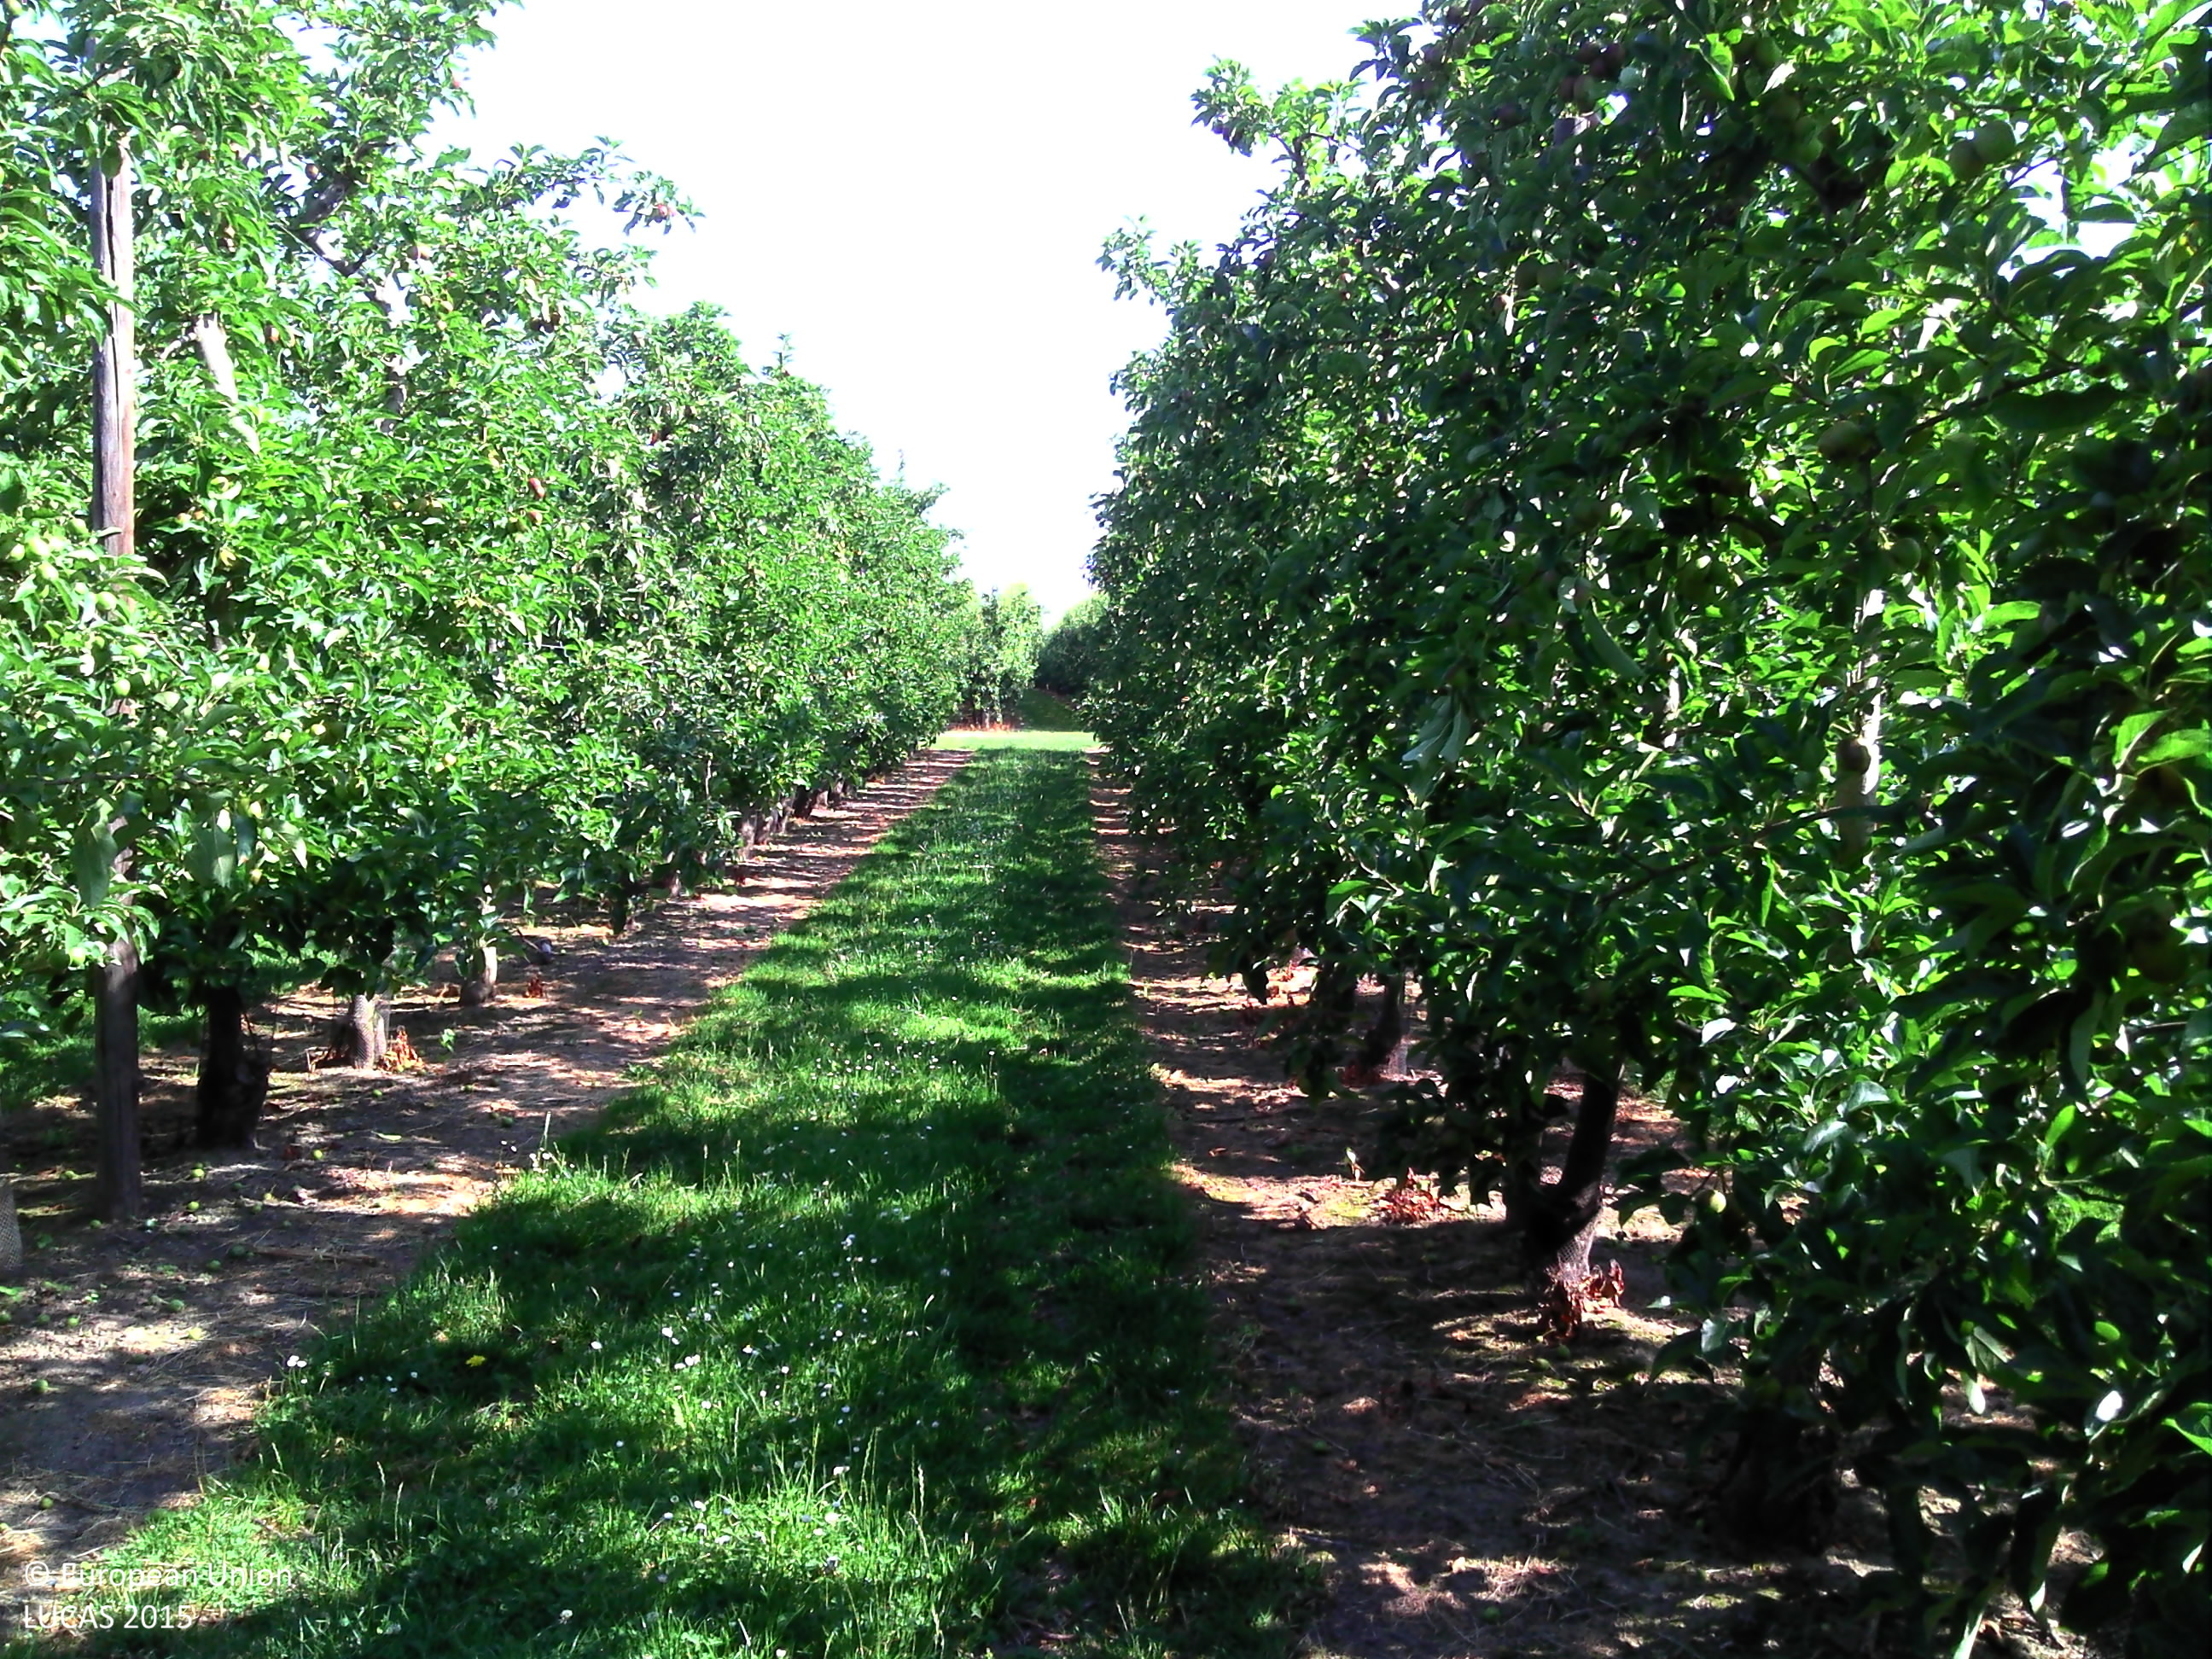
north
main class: Cropland
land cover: Apple fruit
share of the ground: > 75 %
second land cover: Grassland without tree/shrub cover
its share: > 75 %
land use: Agriculture (excluding fallow land and kitchen gardens)
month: June
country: BE
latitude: 50.8032
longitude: 5.1873
